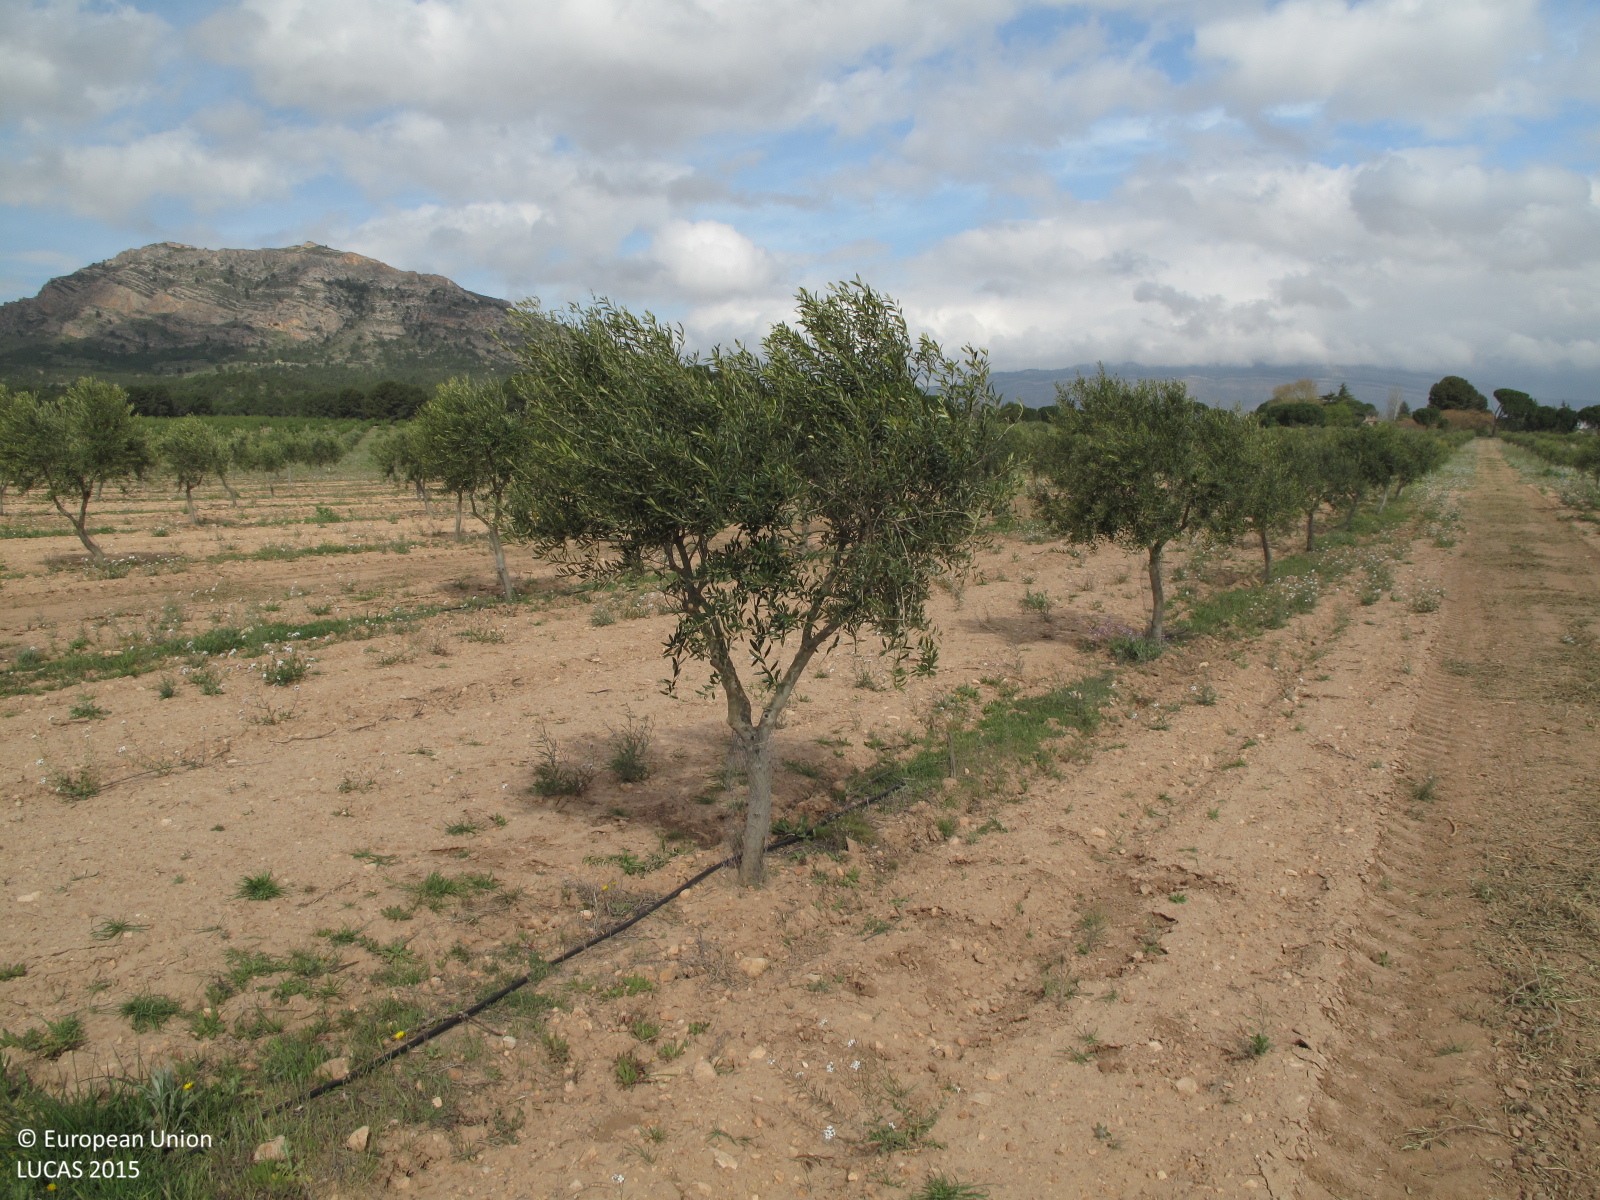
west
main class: Cropland
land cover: Olive groves
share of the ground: < 10 %
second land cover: Spontaneously vegetated surfaces
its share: < 10 %
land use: Agriculture (excluding fallow land and kitchen gardens)
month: April
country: ES
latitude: 38.6649
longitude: -0.9666
